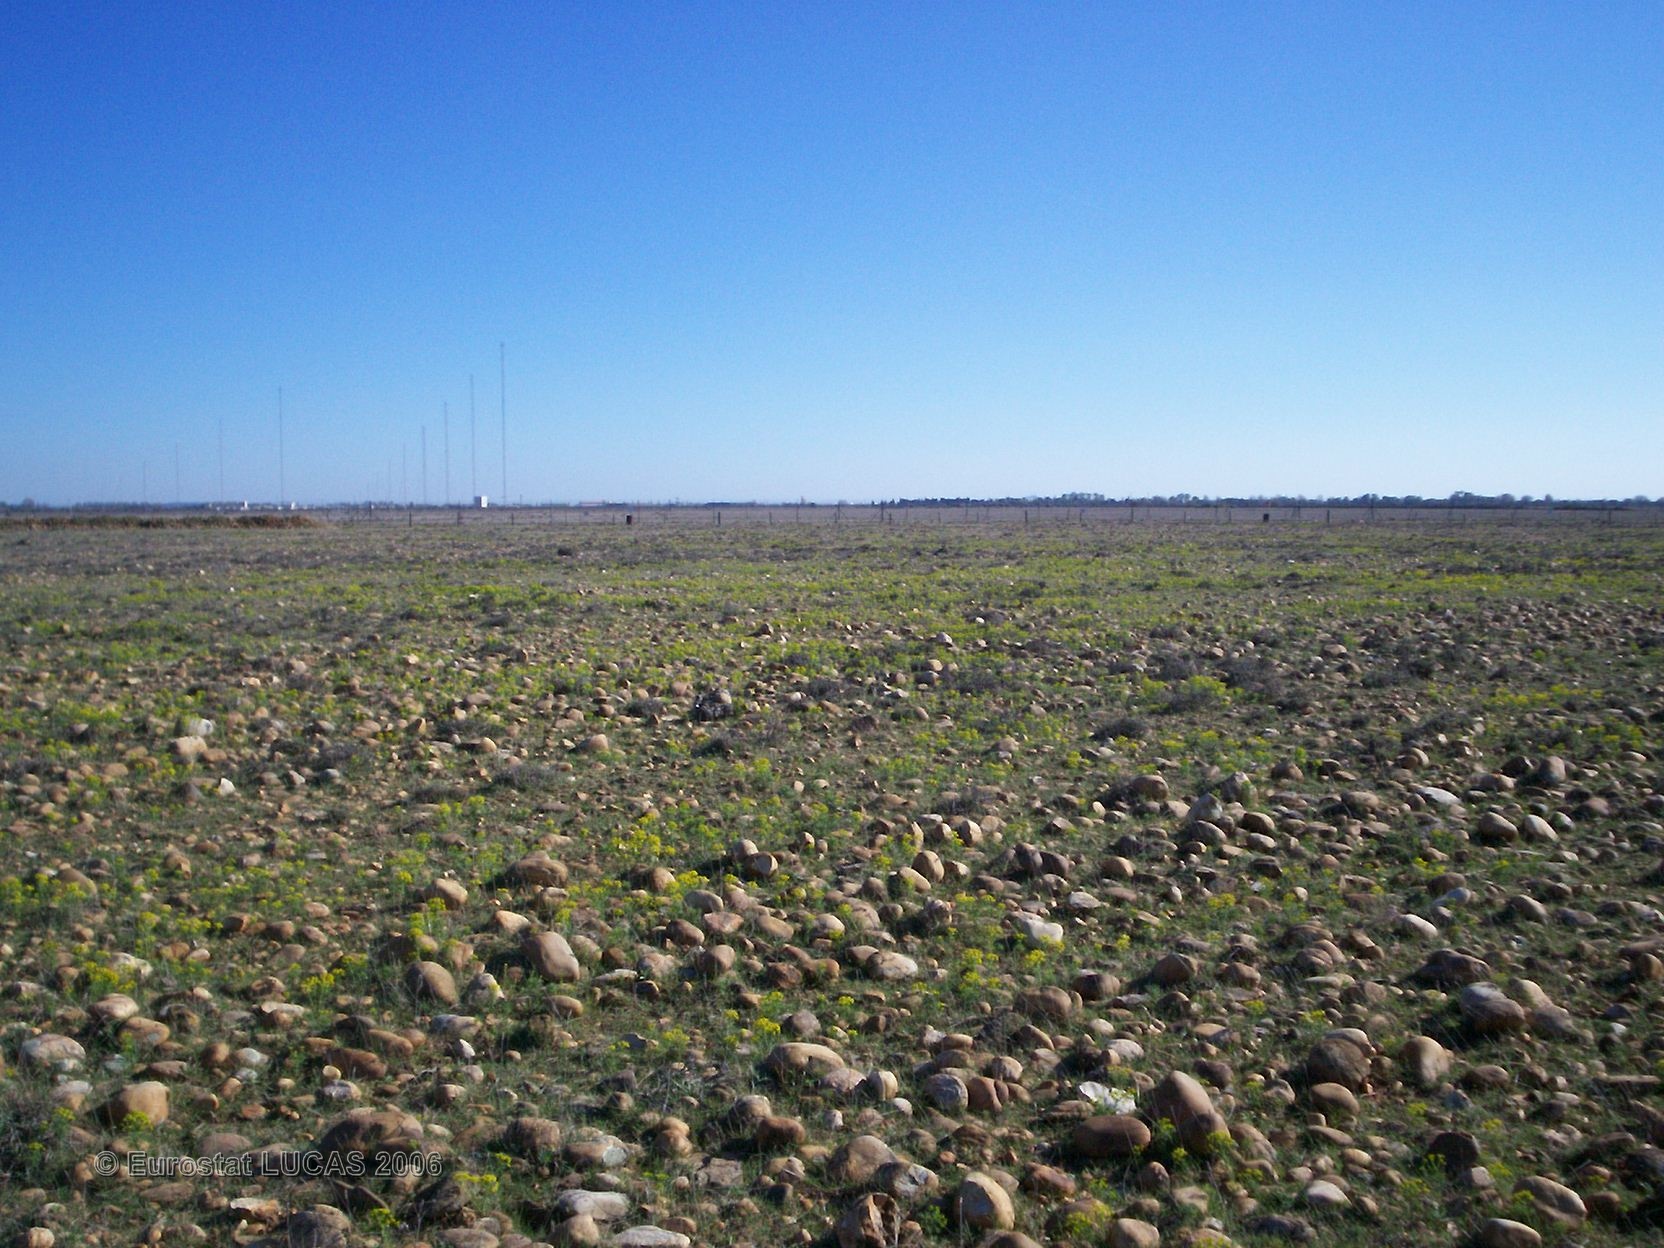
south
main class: Bare land
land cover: Bare land
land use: Unused
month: April
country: FR
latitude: 43.5767
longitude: 4.9450
